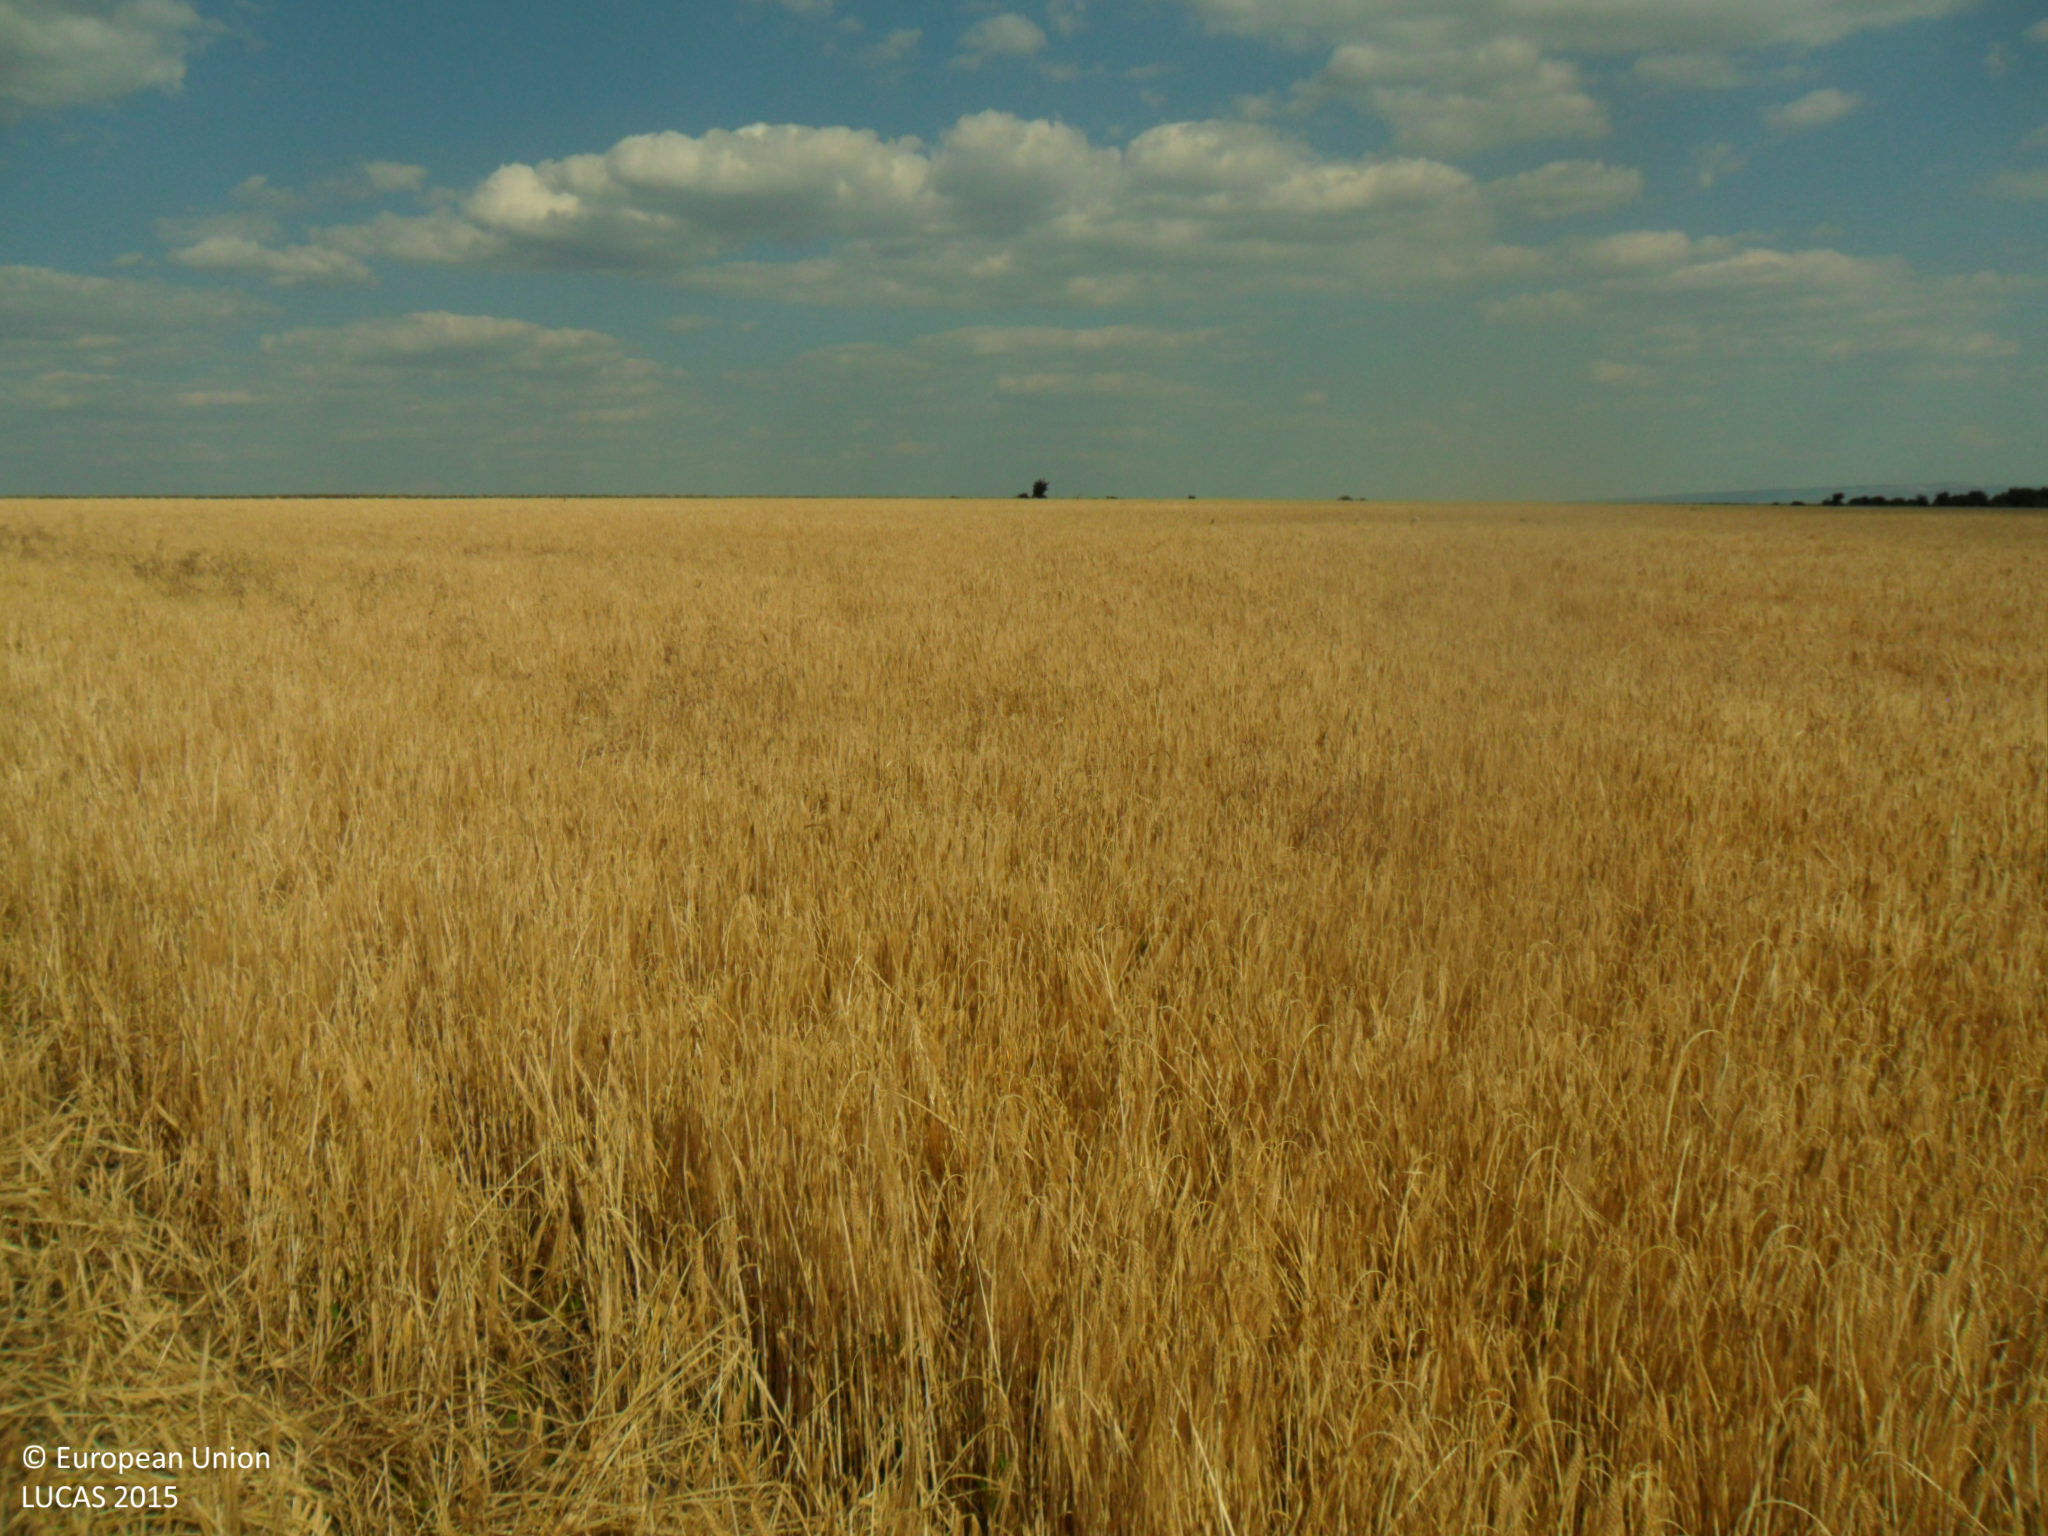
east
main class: Woodland
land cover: Broadleaved woodland
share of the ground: > 75 %
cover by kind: broadleaved forest trees 90 %, shrubs 10 %
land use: Semi-natural and natural areas not in use
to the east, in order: Broadleaved woodland; Grass margins; Barley; Grass margins; Rape and turnip rape
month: June
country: BG
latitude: 43.4827
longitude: 26.9176
